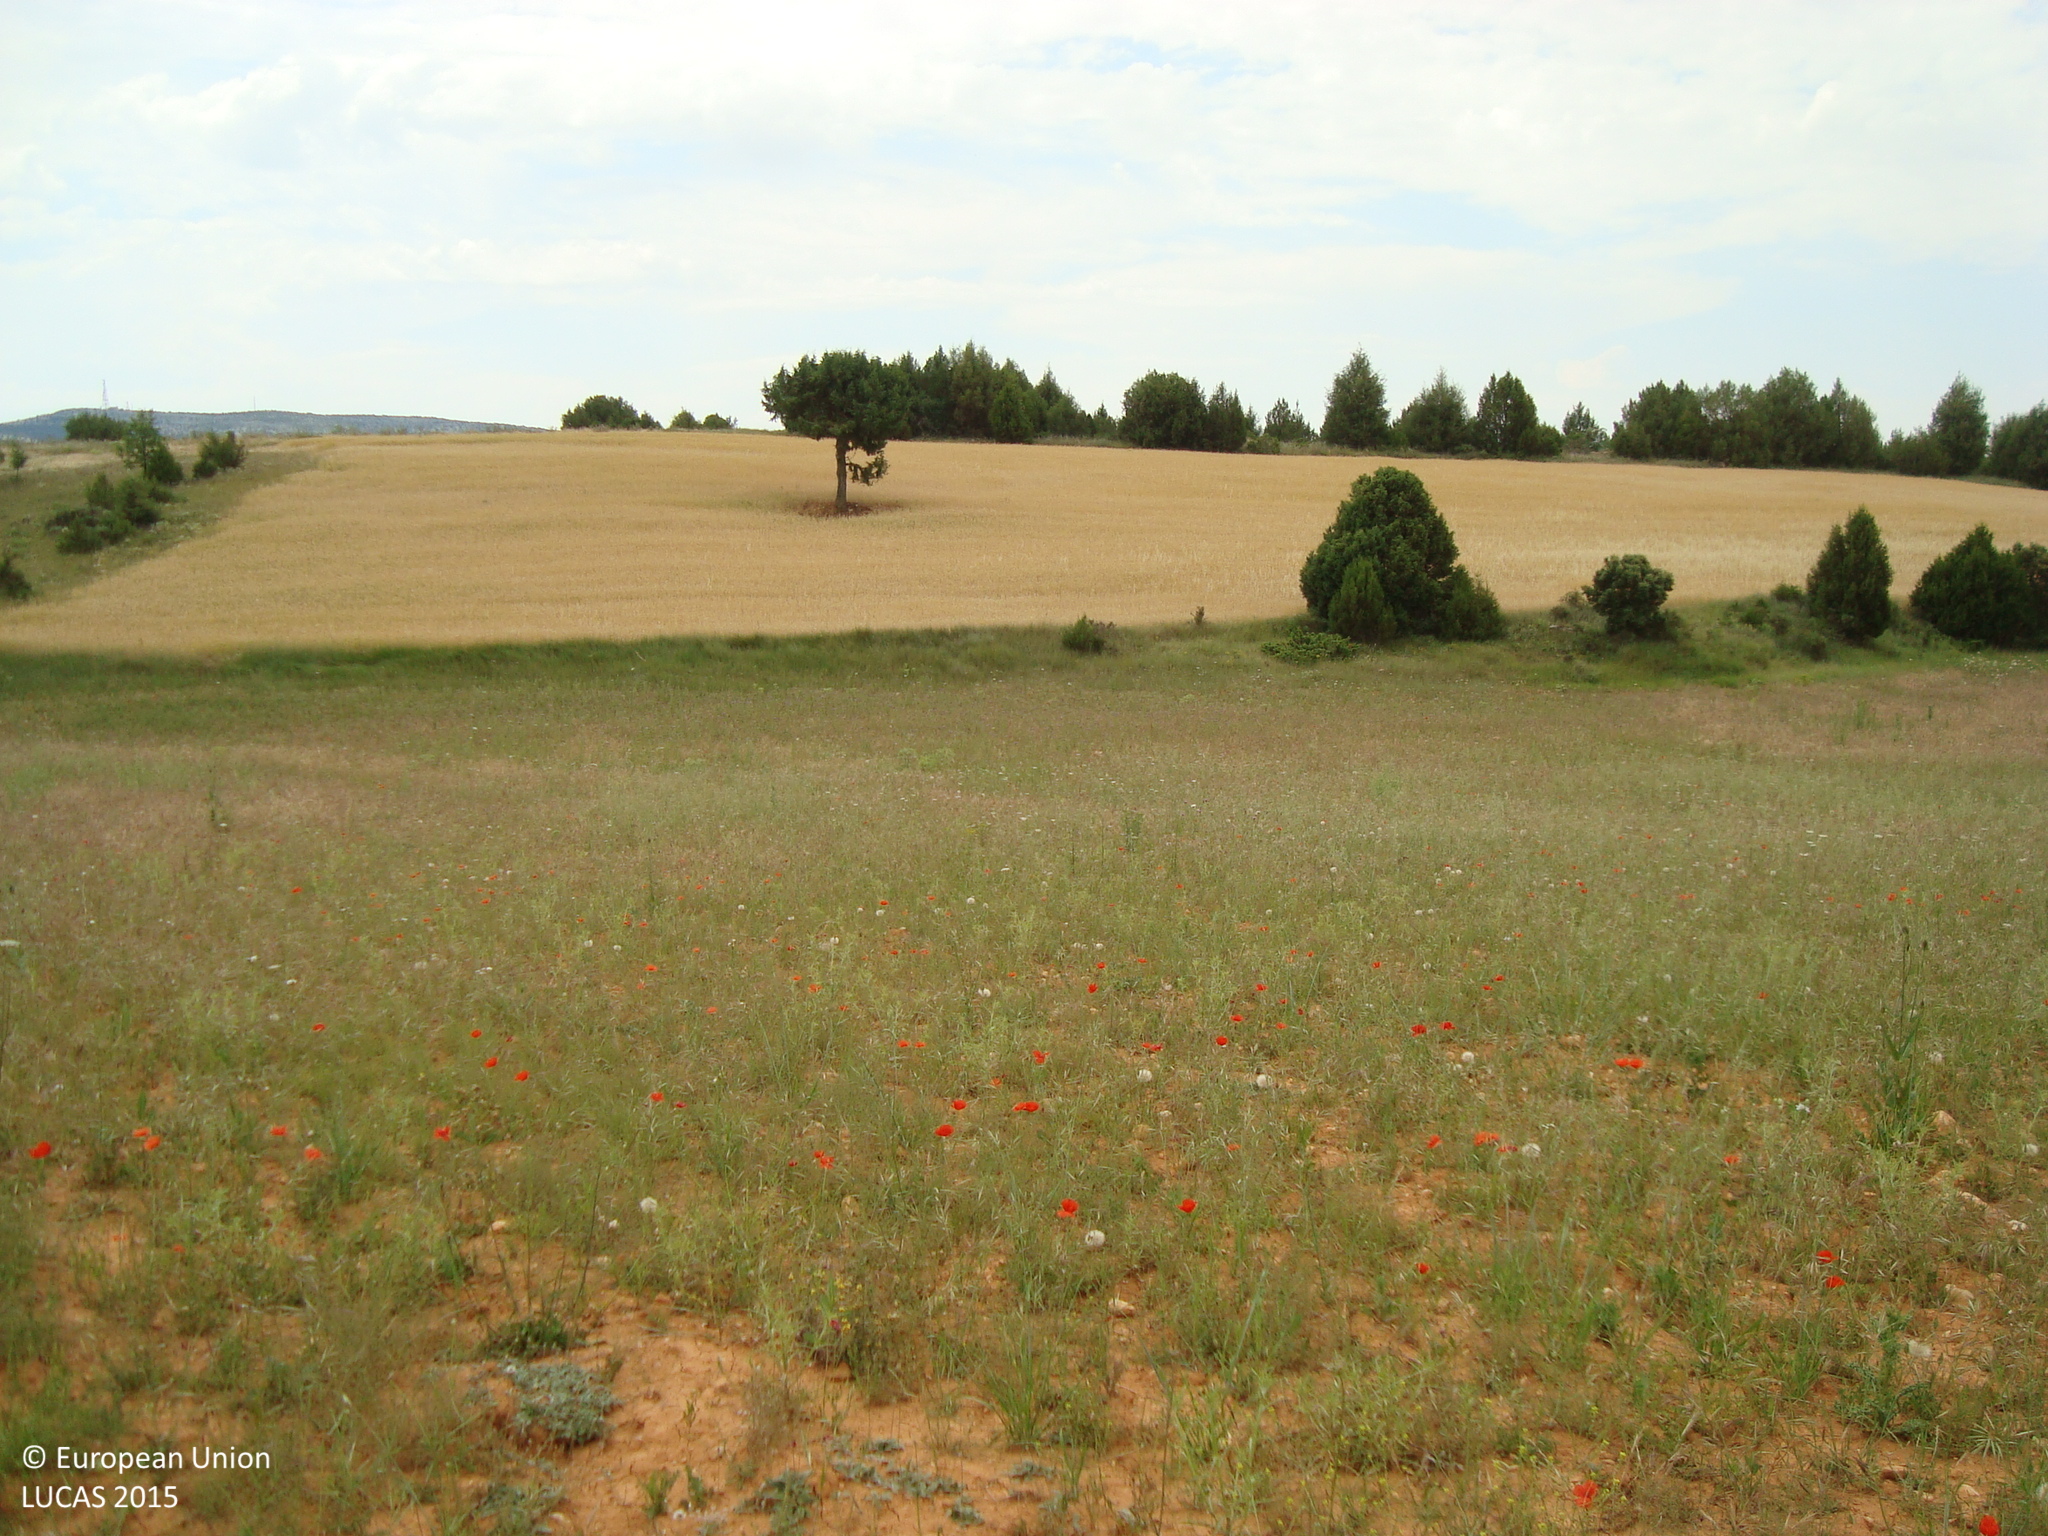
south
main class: Grassland
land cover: Spontaneously vegetated surfaces
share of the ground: 25 - 50 %
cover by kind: unconsolidated bare surface 60 %, herbaceous plants 40 %
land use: Fallow land
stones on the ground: < 10 %
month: June
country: ES
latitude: 41.9898
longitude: -3.5864
